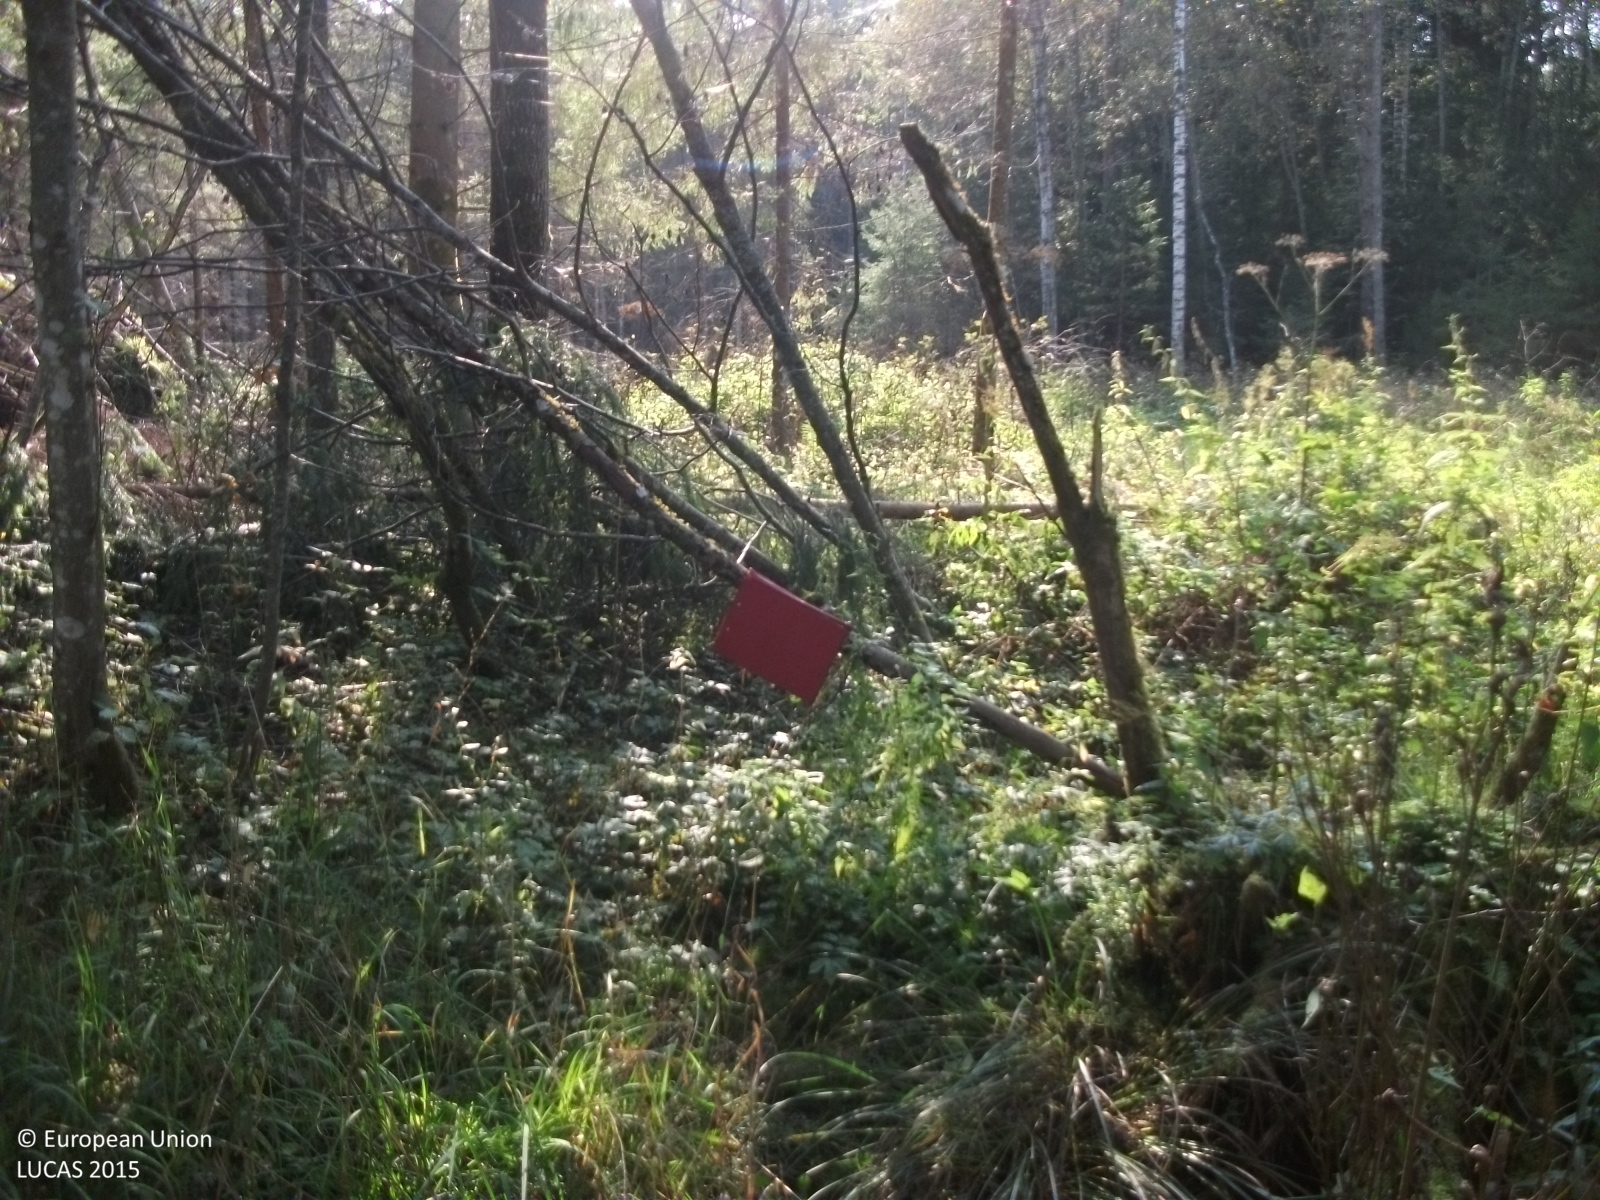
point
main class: Woodland
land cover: Spruce dominated mixed woodland
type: hemiboreal forest and nemoral coniferous forest and mixed broadleaved-coniferous forest
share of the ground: 50 - 75 %
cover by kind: coniferous forest trees 45 %, broadleaved forest trees 25 %, shrubs 15 %, herbaceous plants 15 %
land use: Forestry
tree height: > 5 m
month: September
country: LV
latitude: 57.8244
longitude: 24.5533
